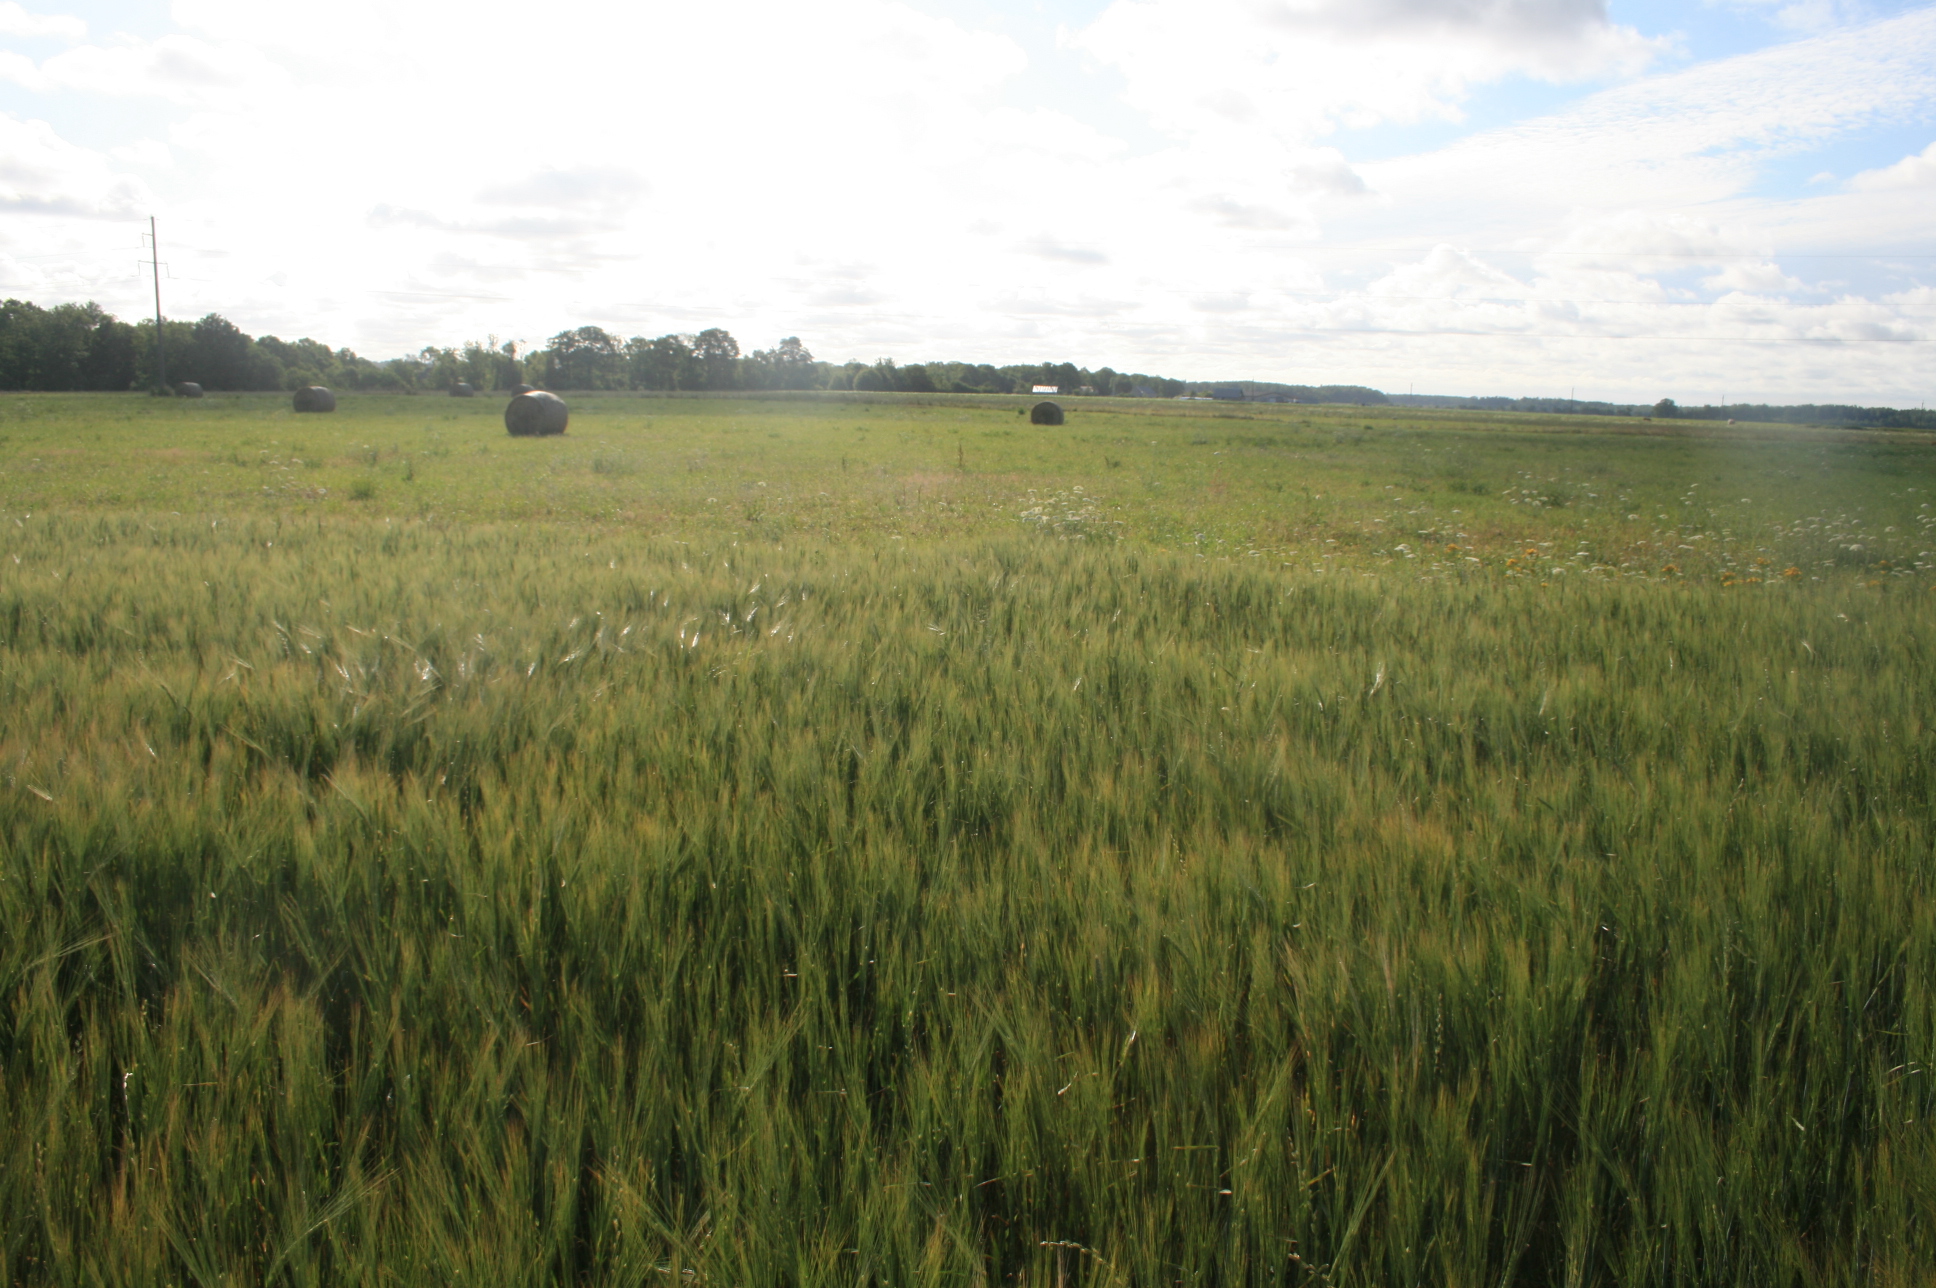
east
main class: Cropland
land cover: Barley
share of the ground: > 75 %
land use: Agriculture (excluding fallow land and kitchen gardens)
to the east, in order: Barley; Grassland without tree/shrub cover; Electric lines; Grassland without tree/shrub cover
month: July
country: LT
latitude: 55.8381
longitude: 21.2346
